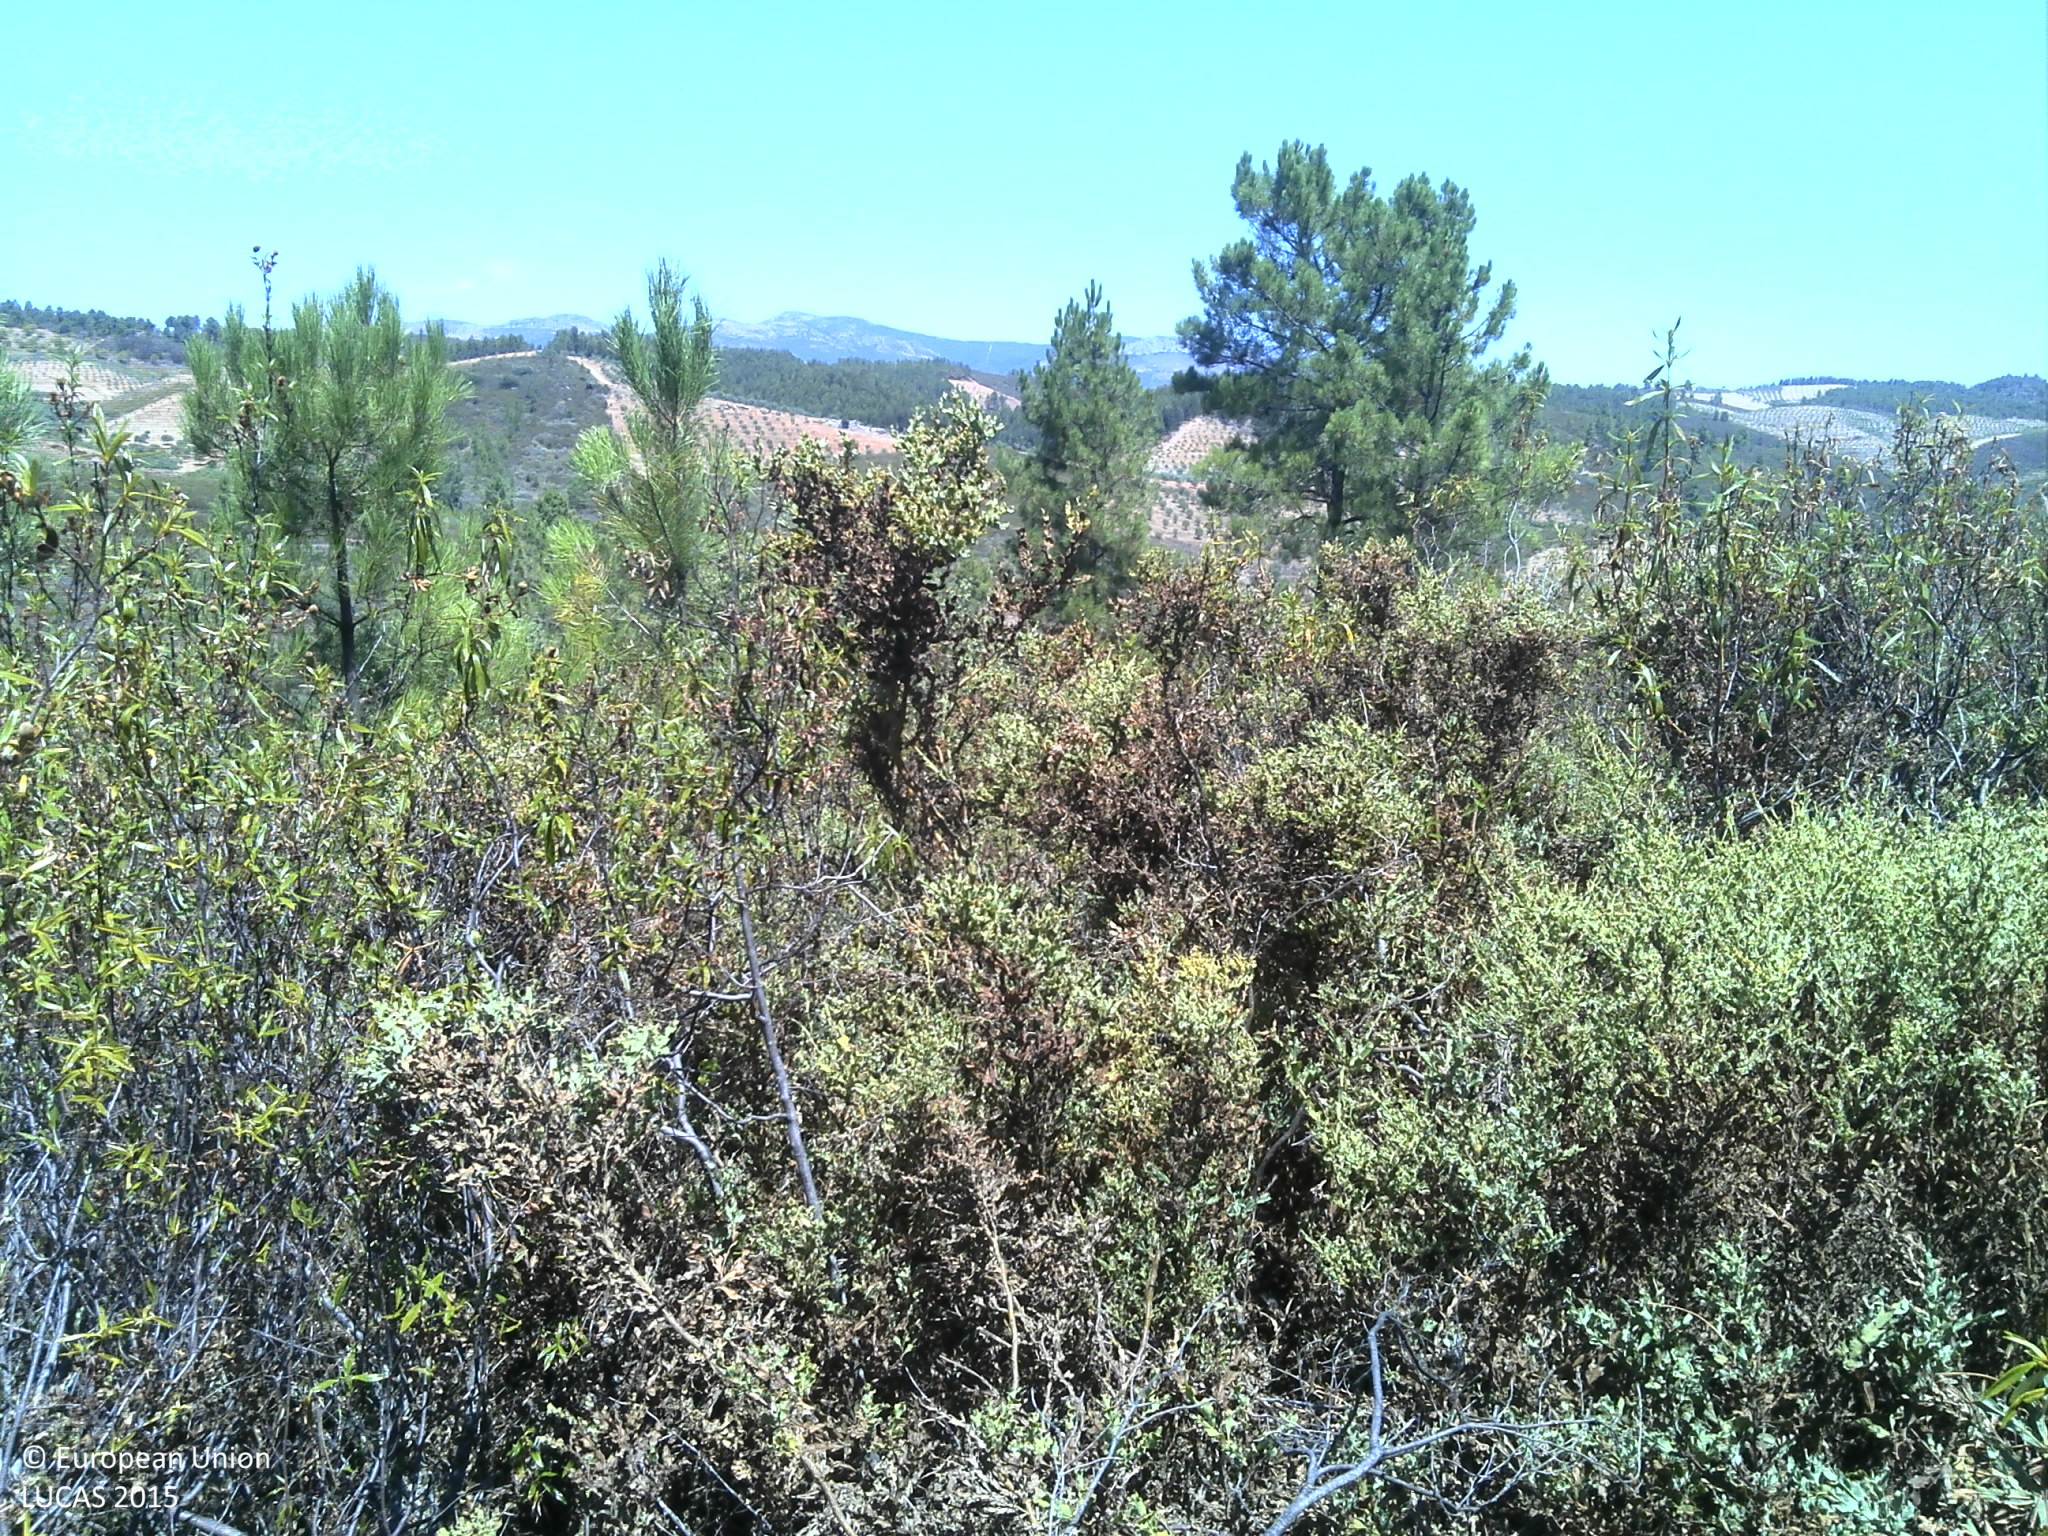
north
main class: Shrubland
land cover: Shrubland with sparse tree cover
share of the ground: > 75 %
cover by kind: shrubs 80 %, unconsolidated bare surface 15 %, coniferous forest trees 5 %
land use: Forestry
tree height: > 5 m
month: July
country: PT
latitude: 41.3647
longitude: -7.3478
